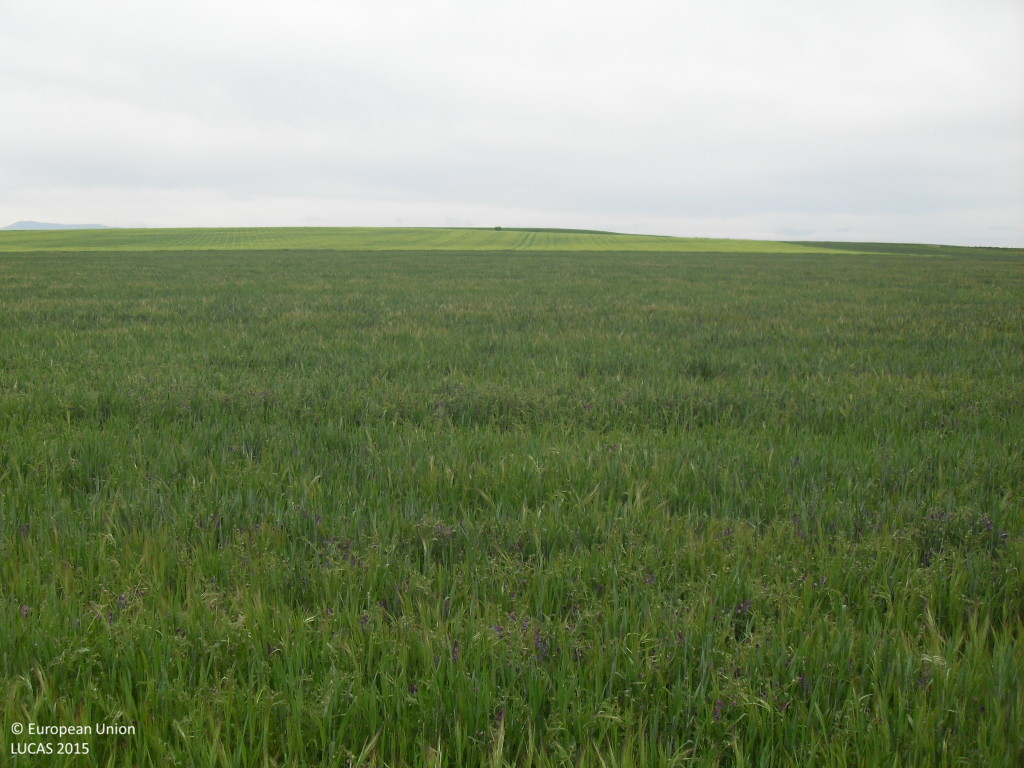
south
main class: Cropland
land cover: Mixed cereals for fodder
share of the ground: > 75 %
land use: Agriculture (excluding fallow land and kitchen gardens)
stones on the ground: 10 - 25 %
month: April
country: ES
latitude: 40.8403
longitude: -5.1879
